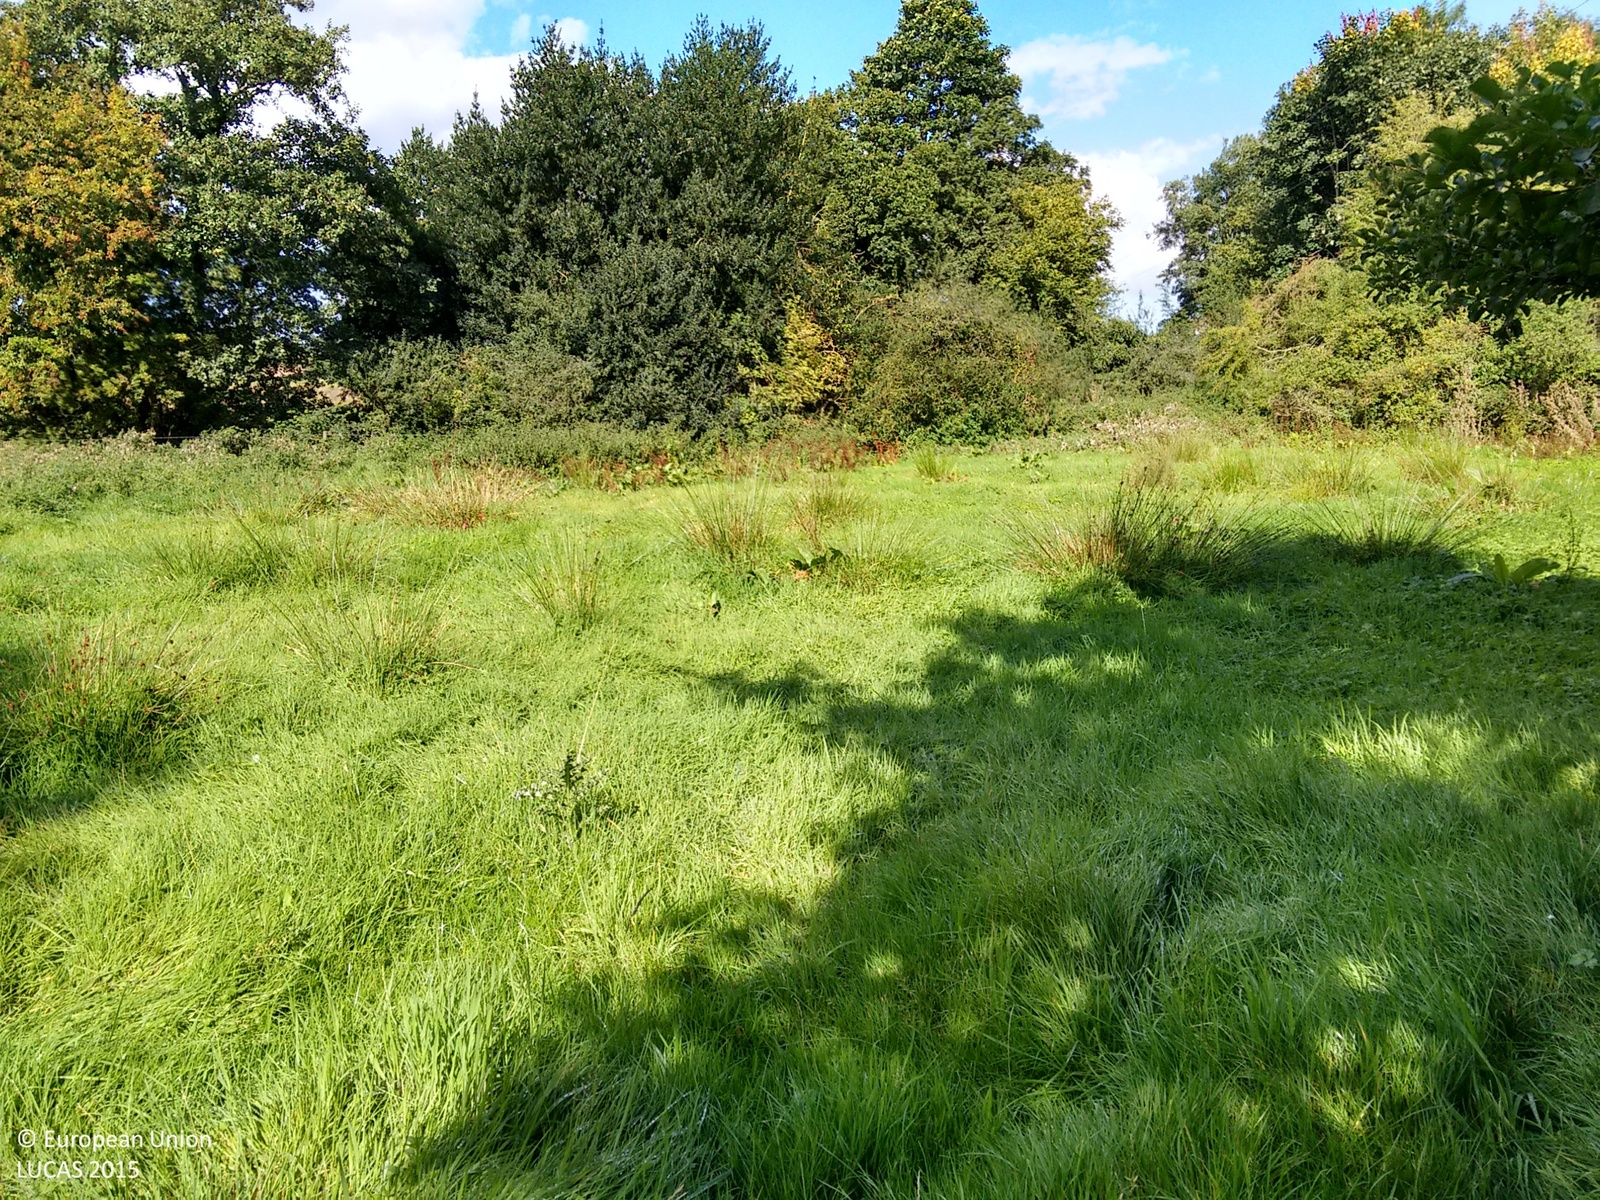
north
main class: Grassland
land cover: Grassland with sparse tree/shrub cover
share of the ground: > 75 %
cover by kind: herbaceous plants 95 %, broadleaved forest trees 5 %
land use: Agriculture (excluding fallow land and kitchen gardens)
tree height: > 5 m
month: September
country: GB
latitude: 52.8306
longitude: 1.2369
